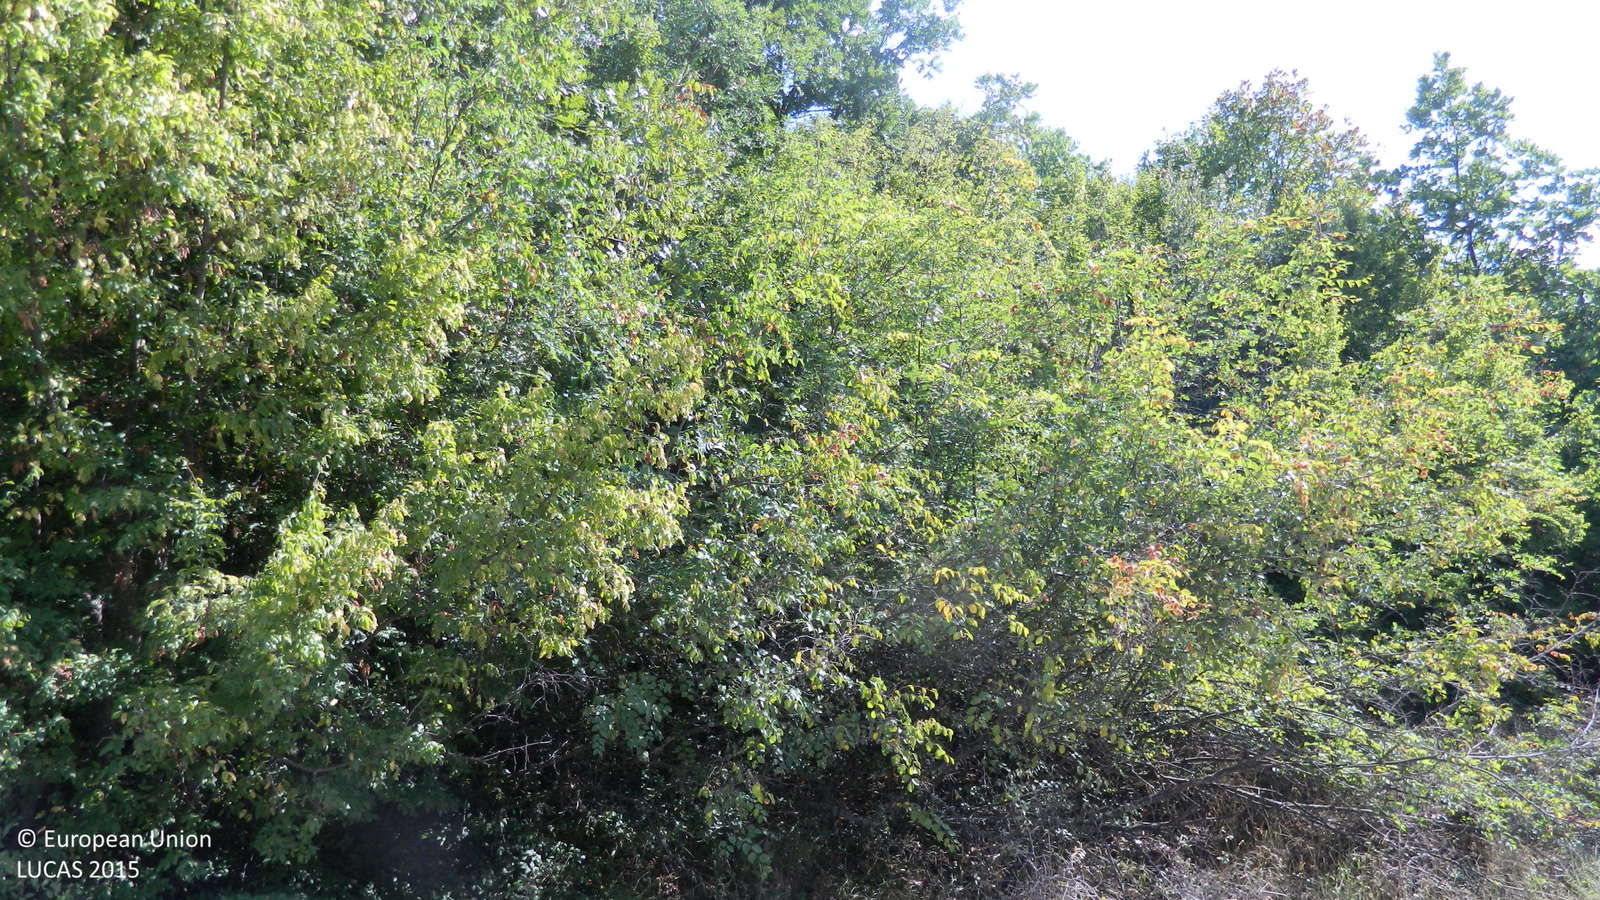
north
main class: Woodland
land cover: Broadleaved woodland
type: mesophytic deciduous forest
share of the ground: > 75 %
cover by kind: broadleaved forest trees 90 %, shrubs 5 %, herbaceous plants 5 %
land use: Forestry
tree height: > 5 m
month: August
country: BG
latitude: 41.6881
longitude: 25.8663
